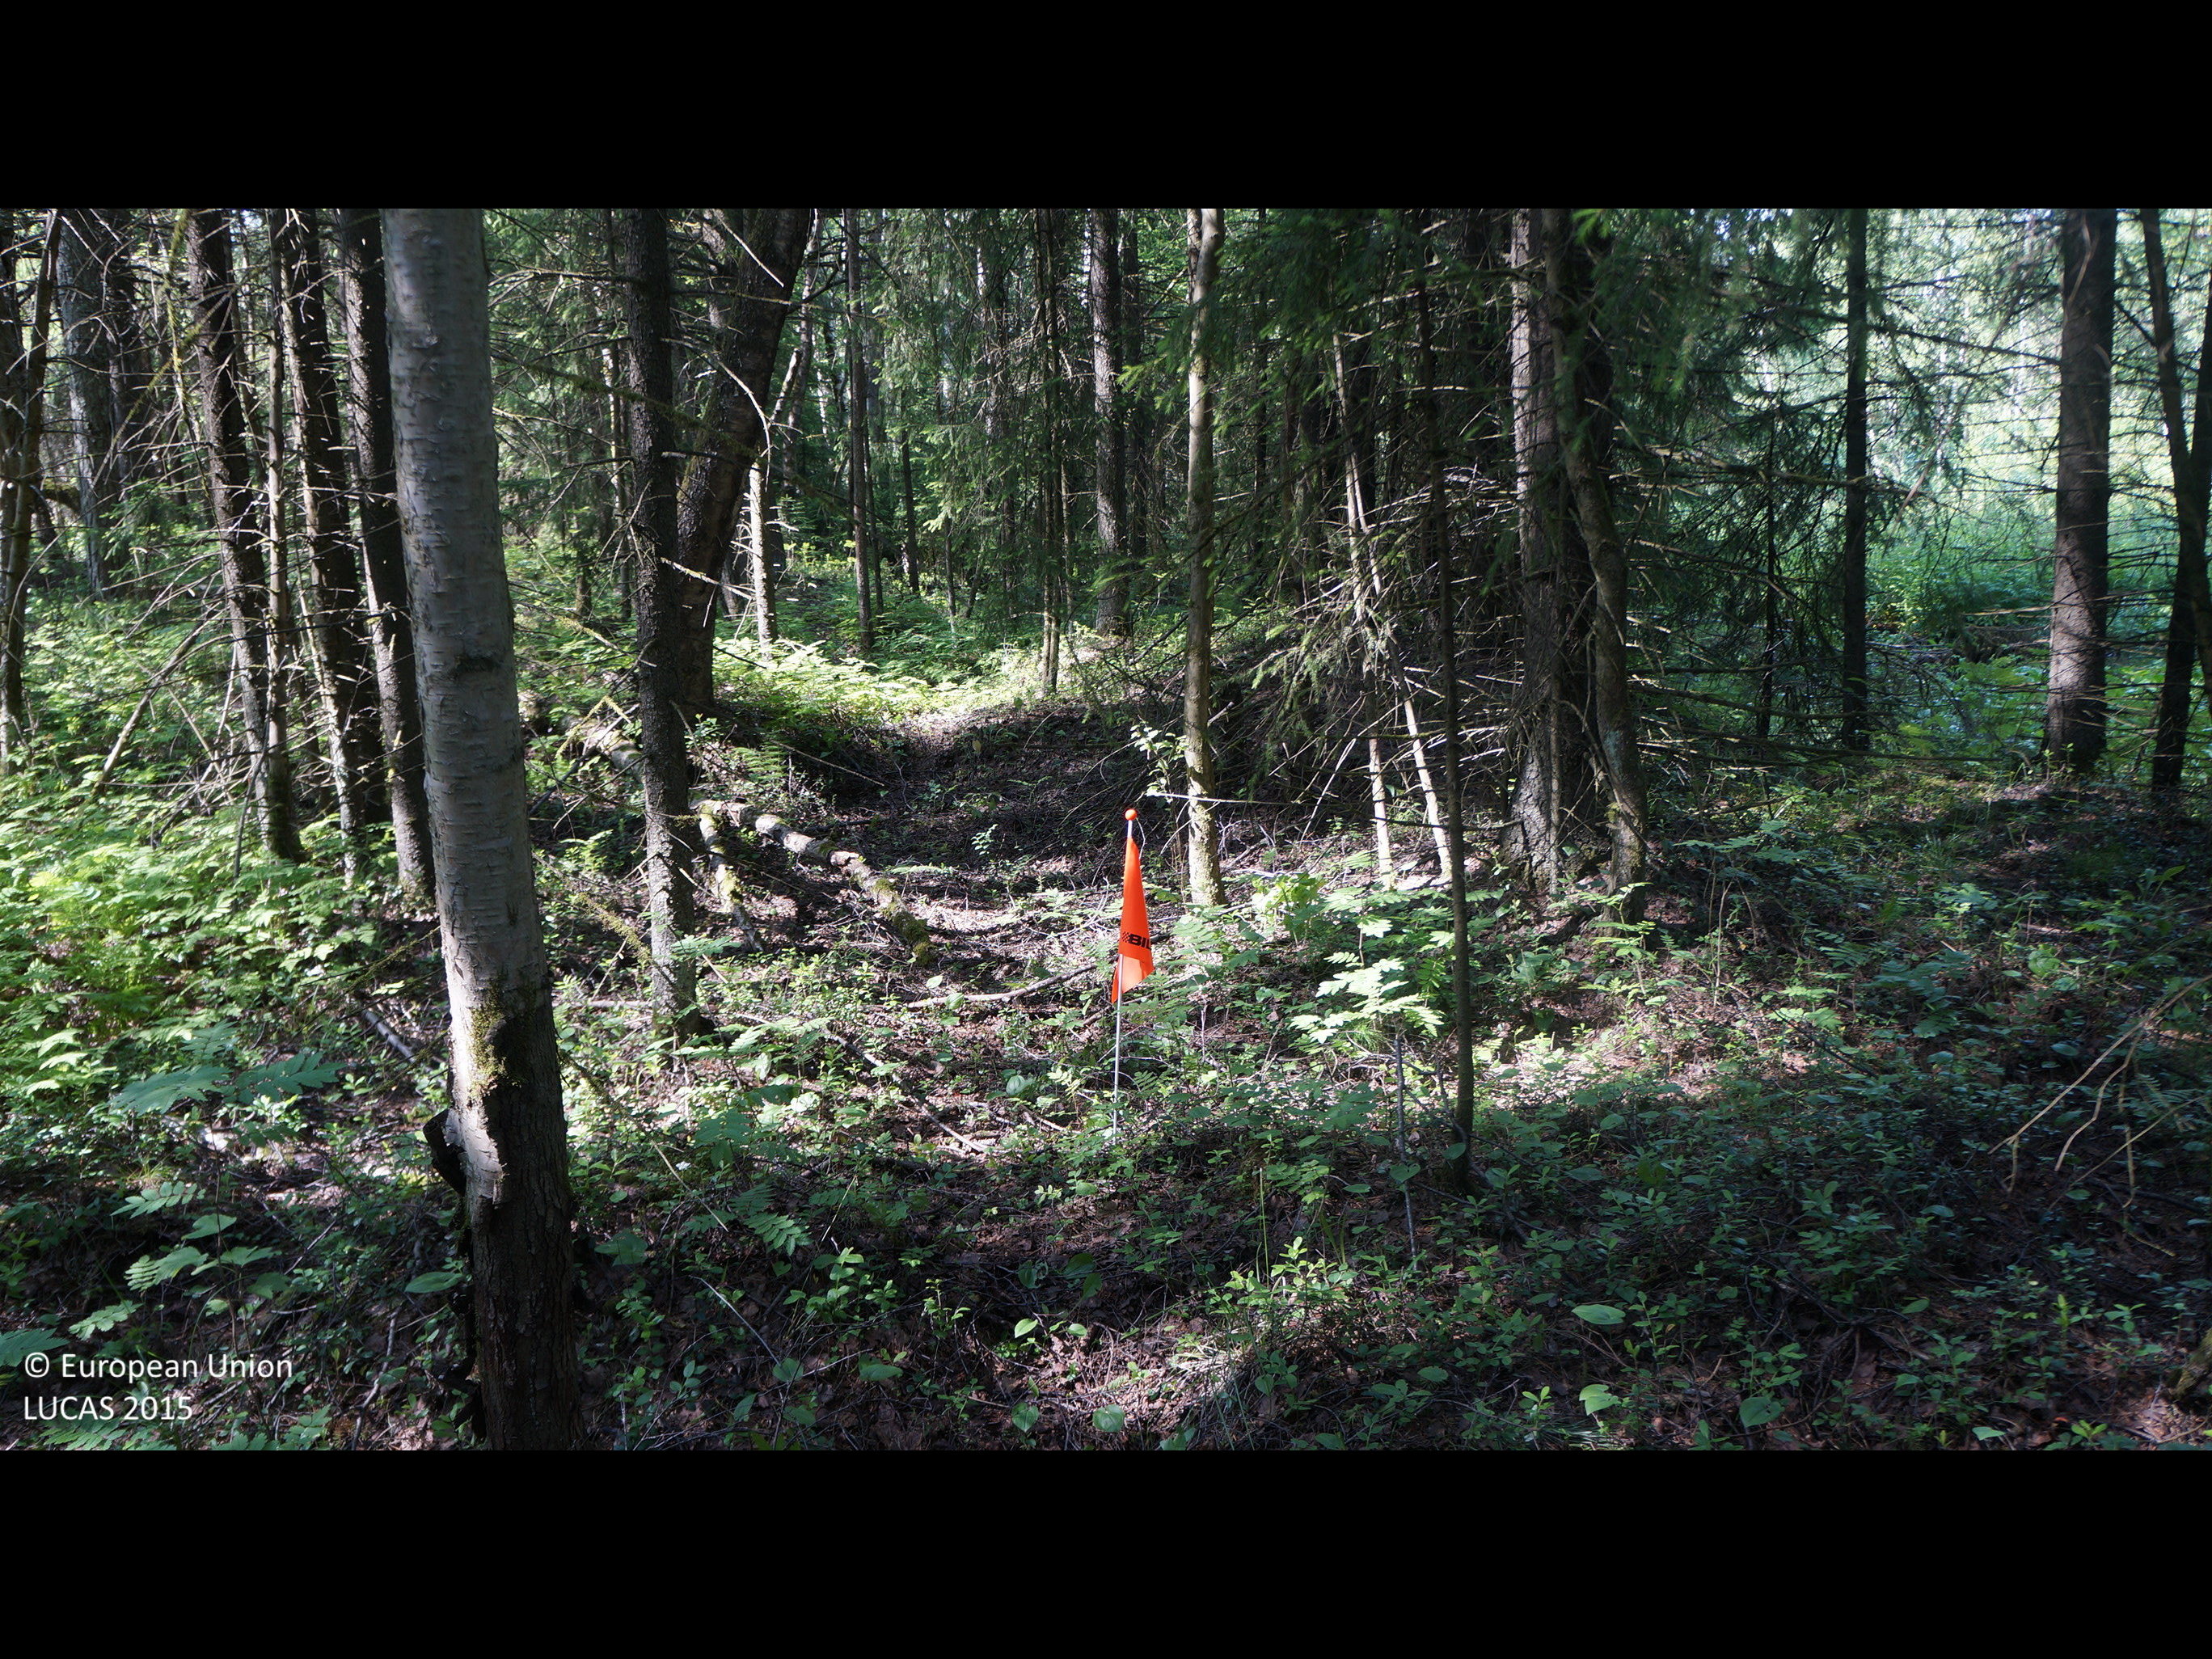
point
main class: Woodland
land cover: Spruce dominated mixed woodland
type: boreal forest
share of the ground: > 75 %
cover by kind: coniferous forest trees 60 %, broadleaved forest trees 20 %, shrubs 10 %, herbaceous plants 5 %, lichens and mosses 5 %
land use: Forestry
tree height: > 5 m
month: July
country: FI
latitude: 64.6537
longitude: 24.4495
